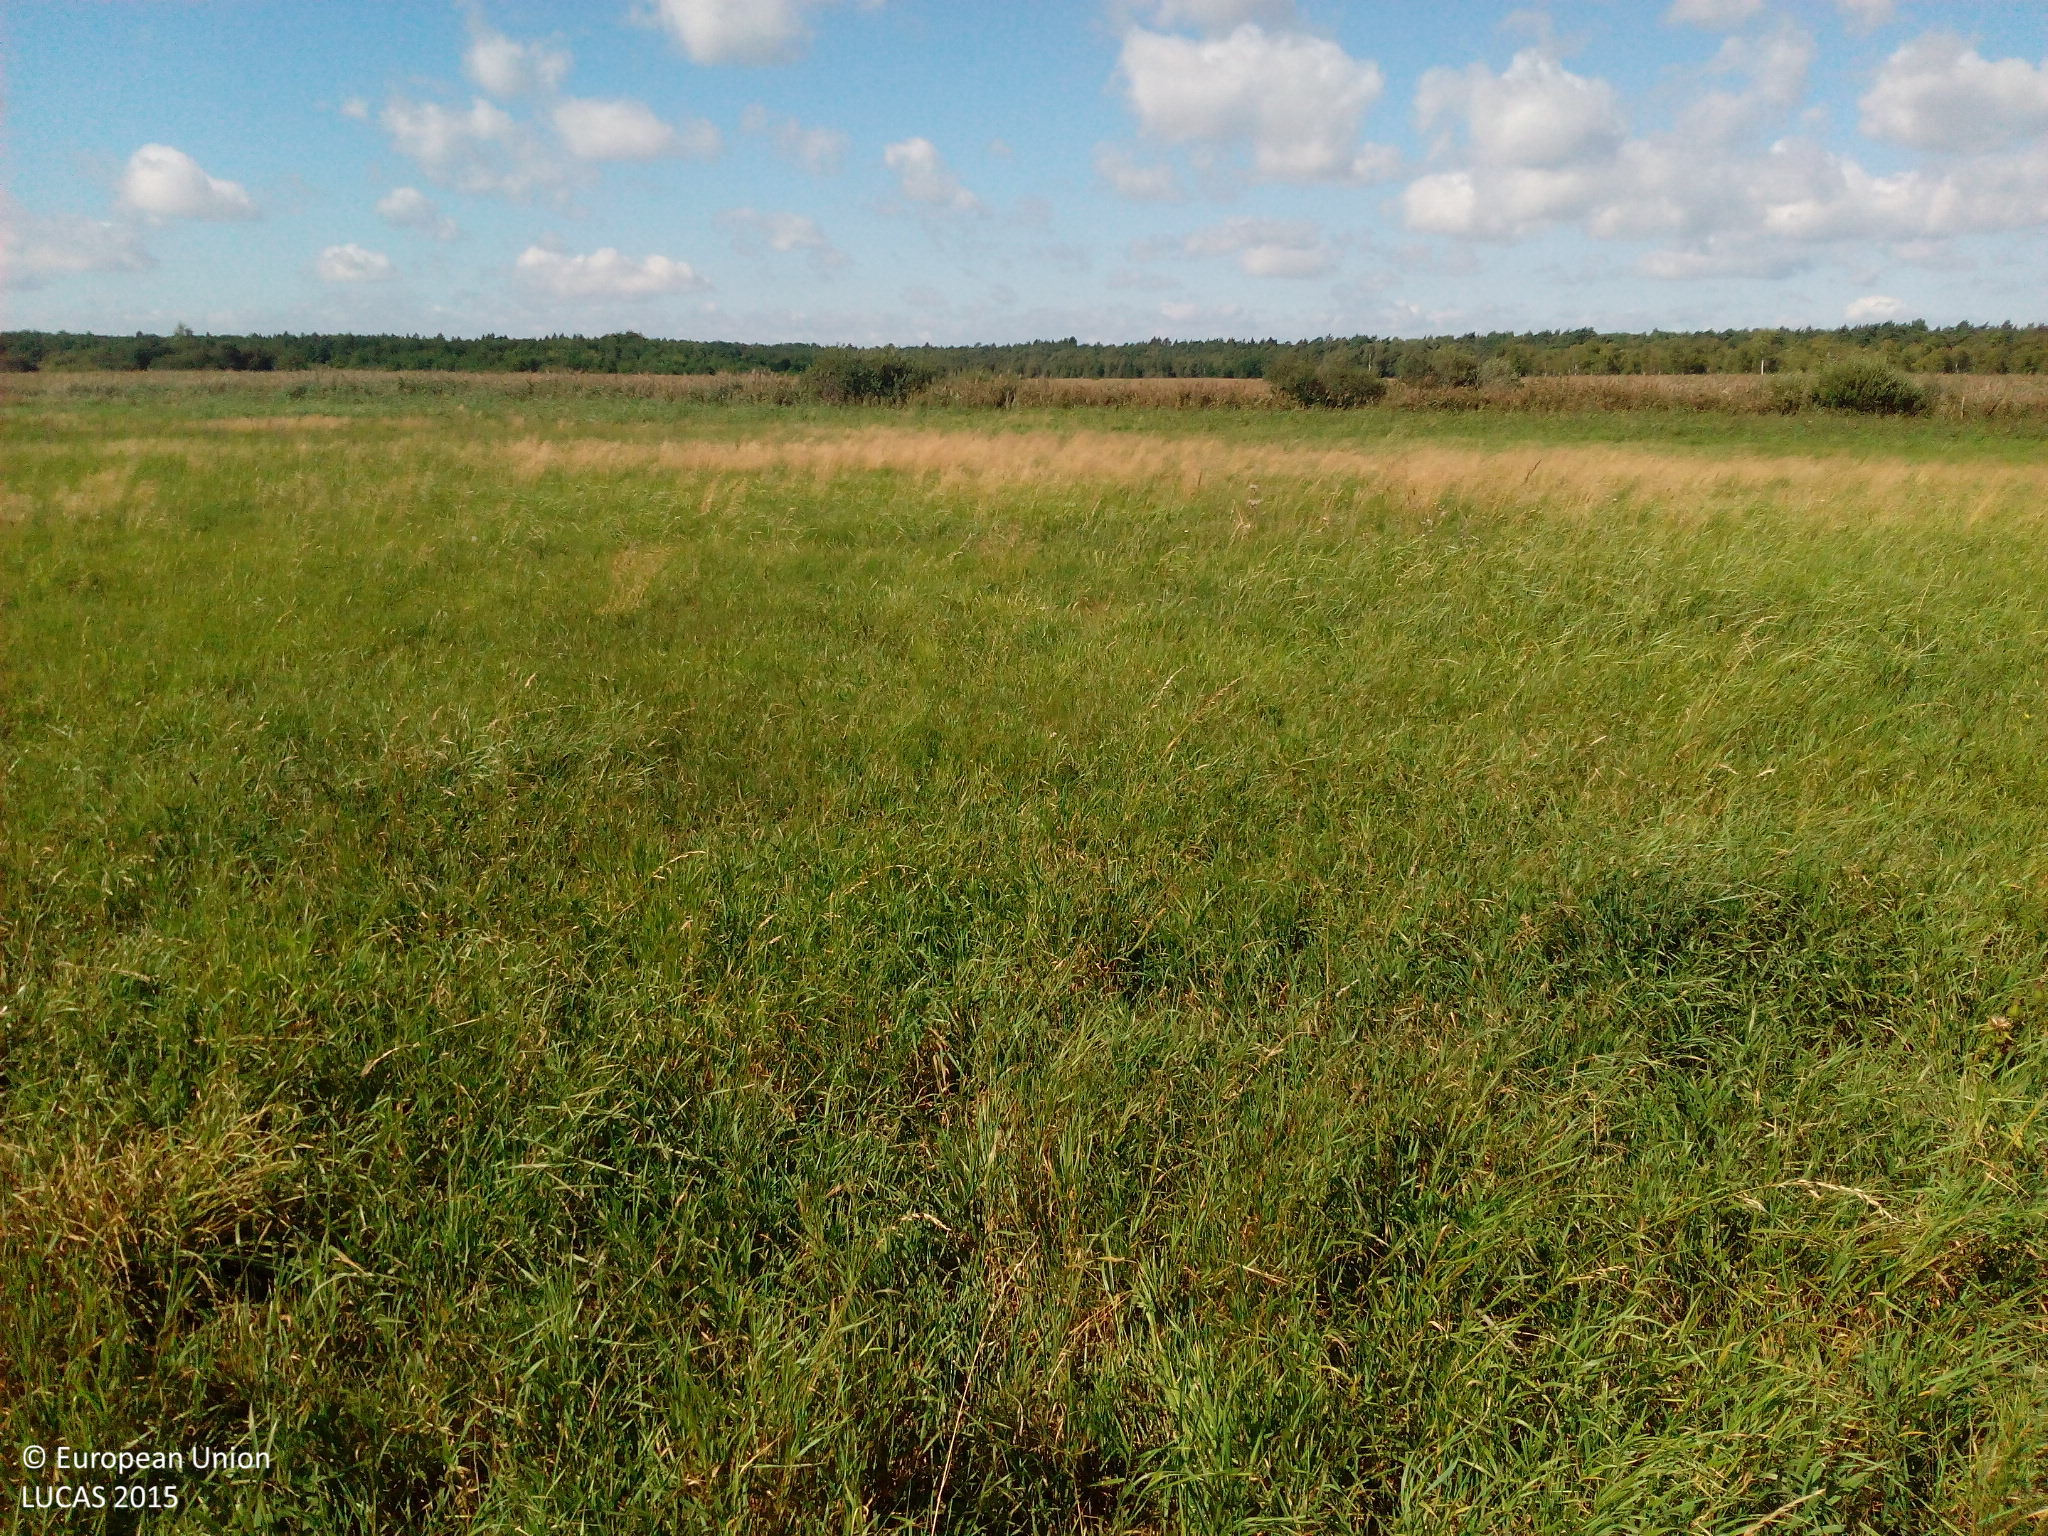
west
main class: Grassland
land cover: Grassland without tree/shrub cover
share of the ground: > 75 %
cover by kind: herbaceous plants 100 %
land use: Agriculture (excluding fallow land and kitchen gardens)
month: September
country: DE
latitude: 53.9908
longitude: 12.3327
